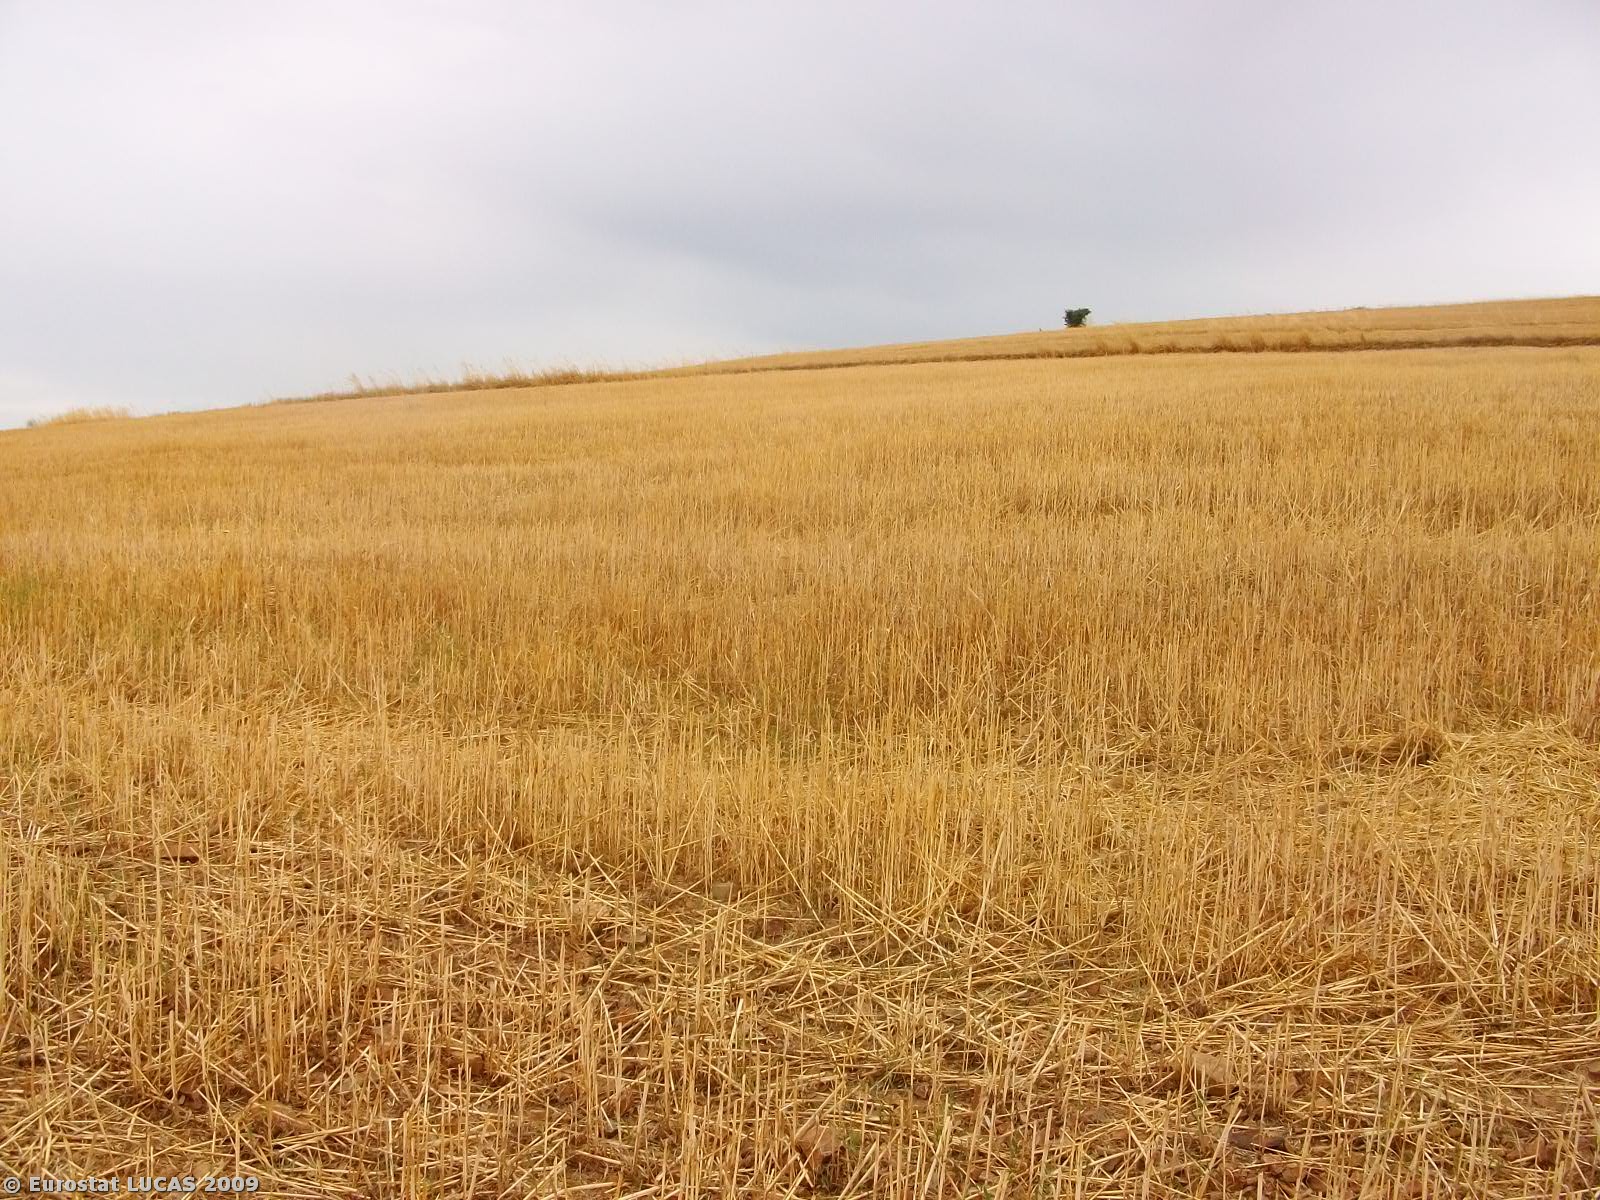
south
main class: Cropland
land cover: Durum wheat
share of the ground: > 75 %
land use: Agriculture (excluding fallow land and kitchen gardens)
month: June
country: GR
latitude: 40.9340
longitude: 22.7280
